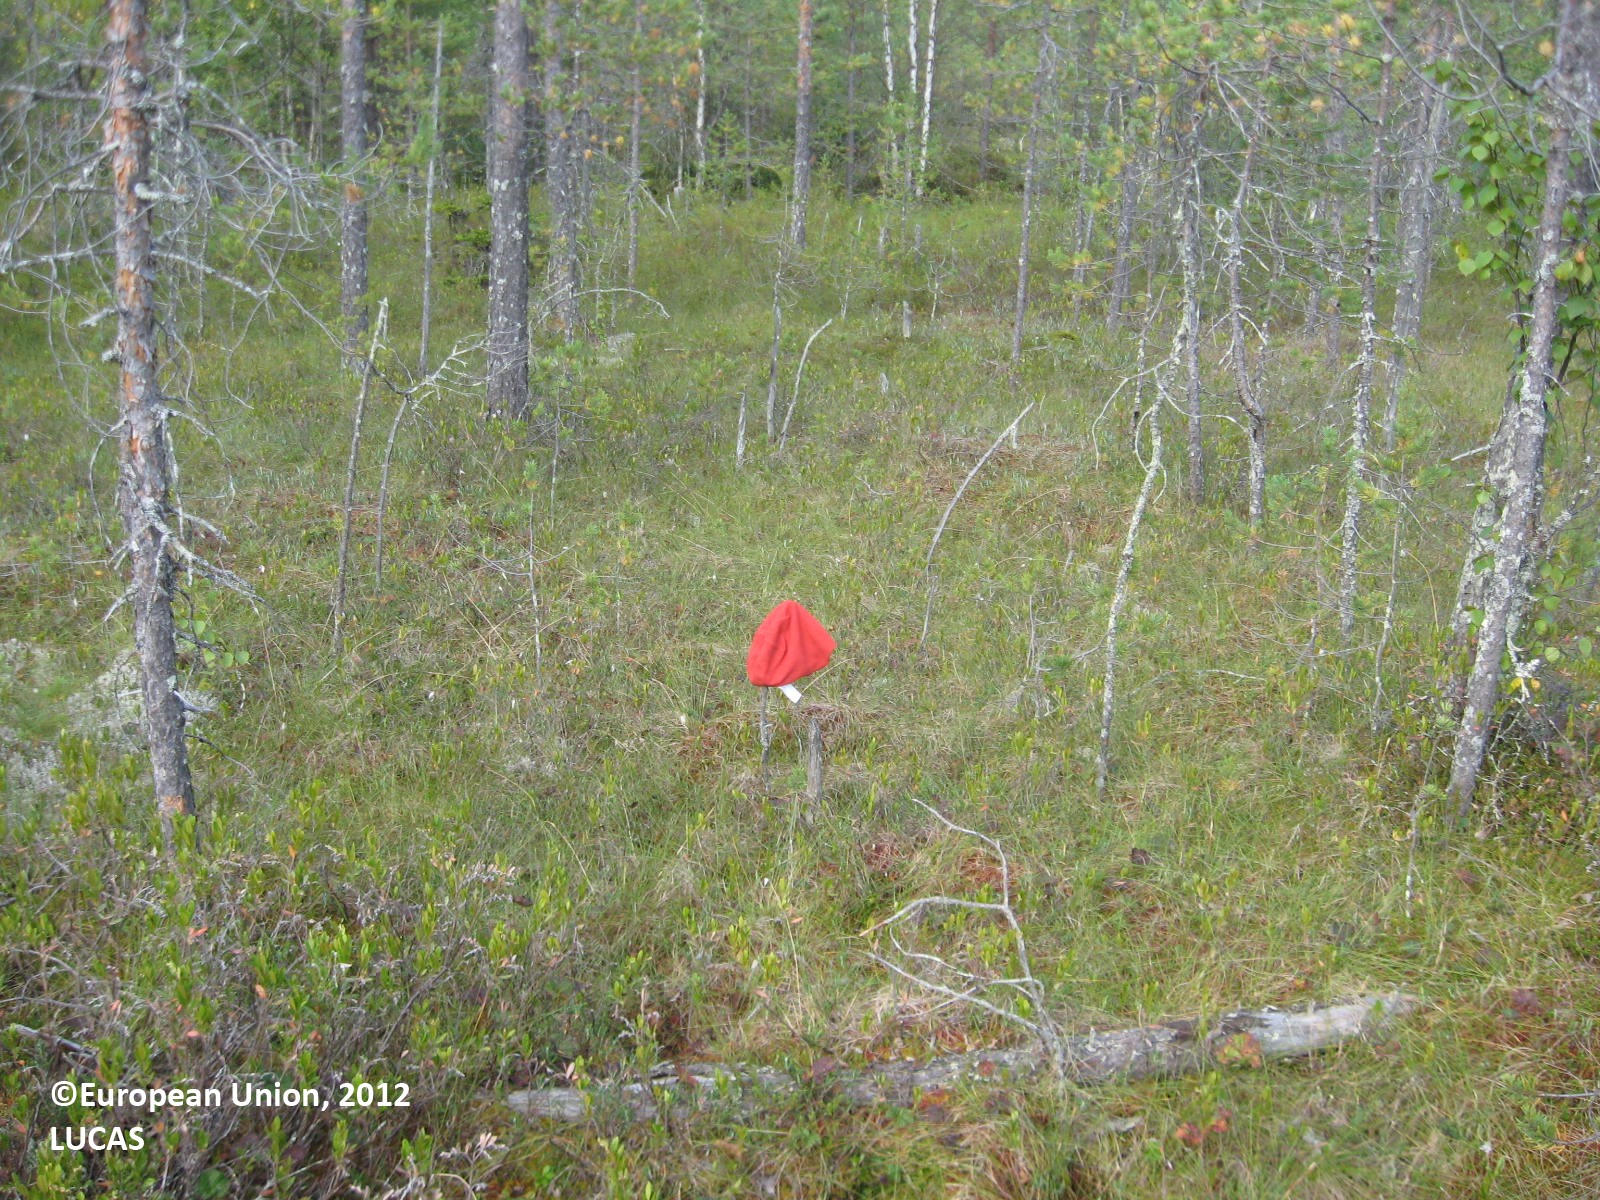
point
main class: Woodland
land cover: Pine dominated coniferous woodland
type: boreal forest
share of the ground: 50 - 75 %
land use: Forestry
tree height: > 5 m
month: August
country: FI
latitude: 63.7060
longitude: 29.9717
